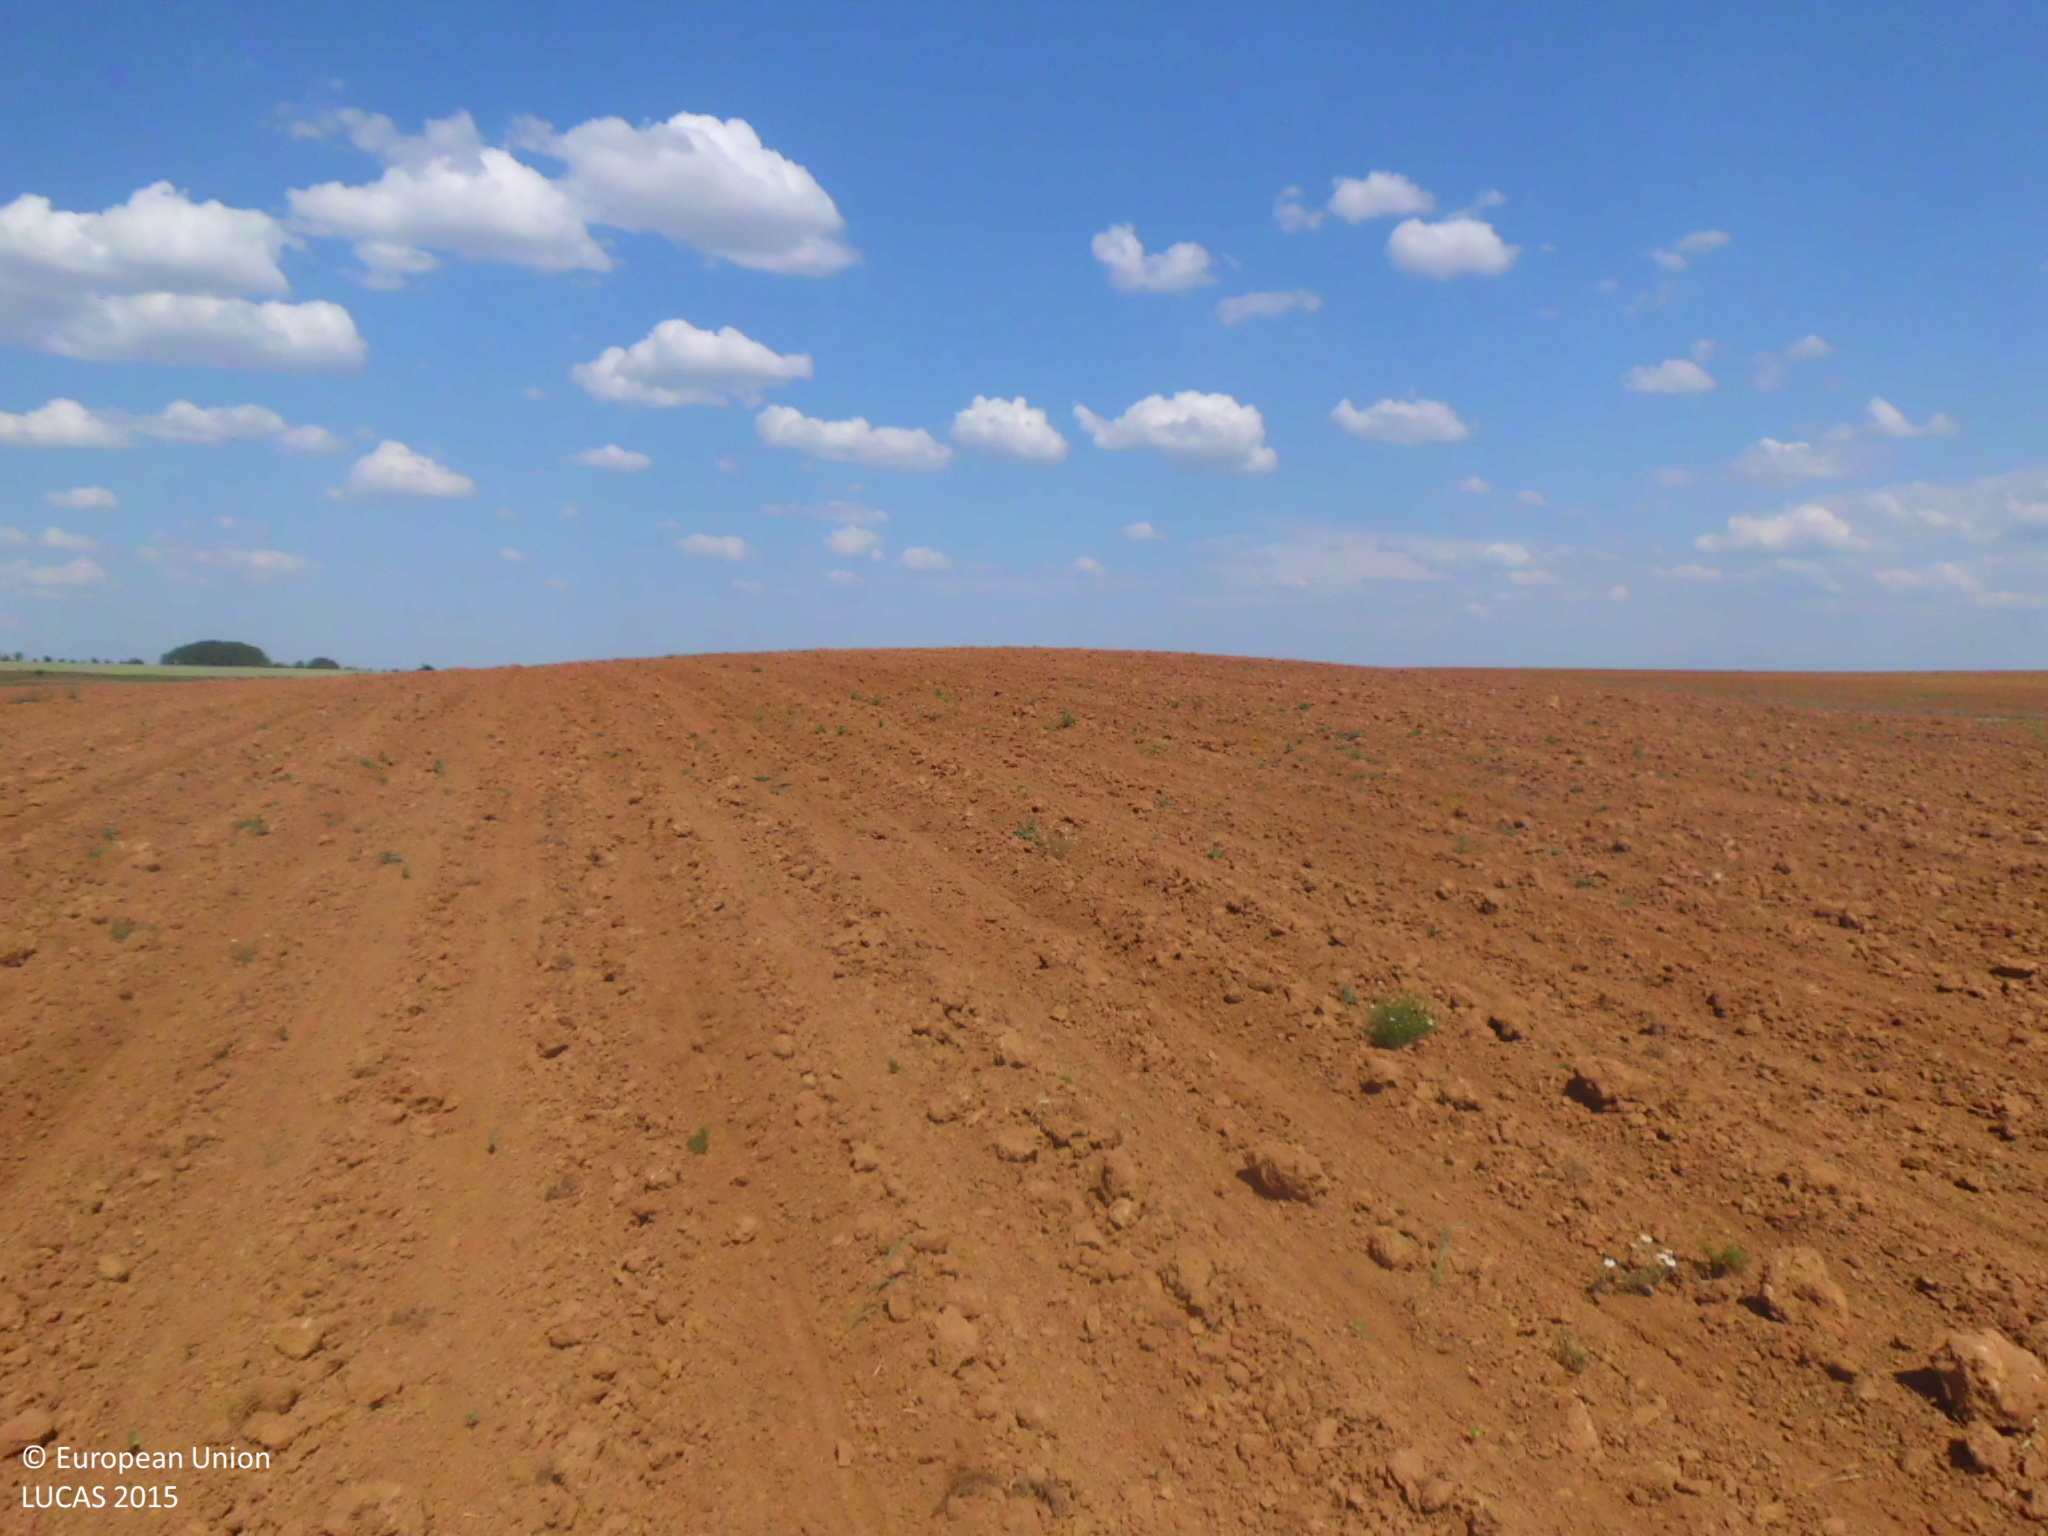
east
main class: Cropland
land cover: Sunflower
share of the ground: < 10 %
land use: Agriculture (excluding fallow land and kitchen gardens)
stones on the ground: < 10 %
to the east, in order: Sunflower
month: June
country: ES
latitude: 42.4340
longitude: -4.2068
